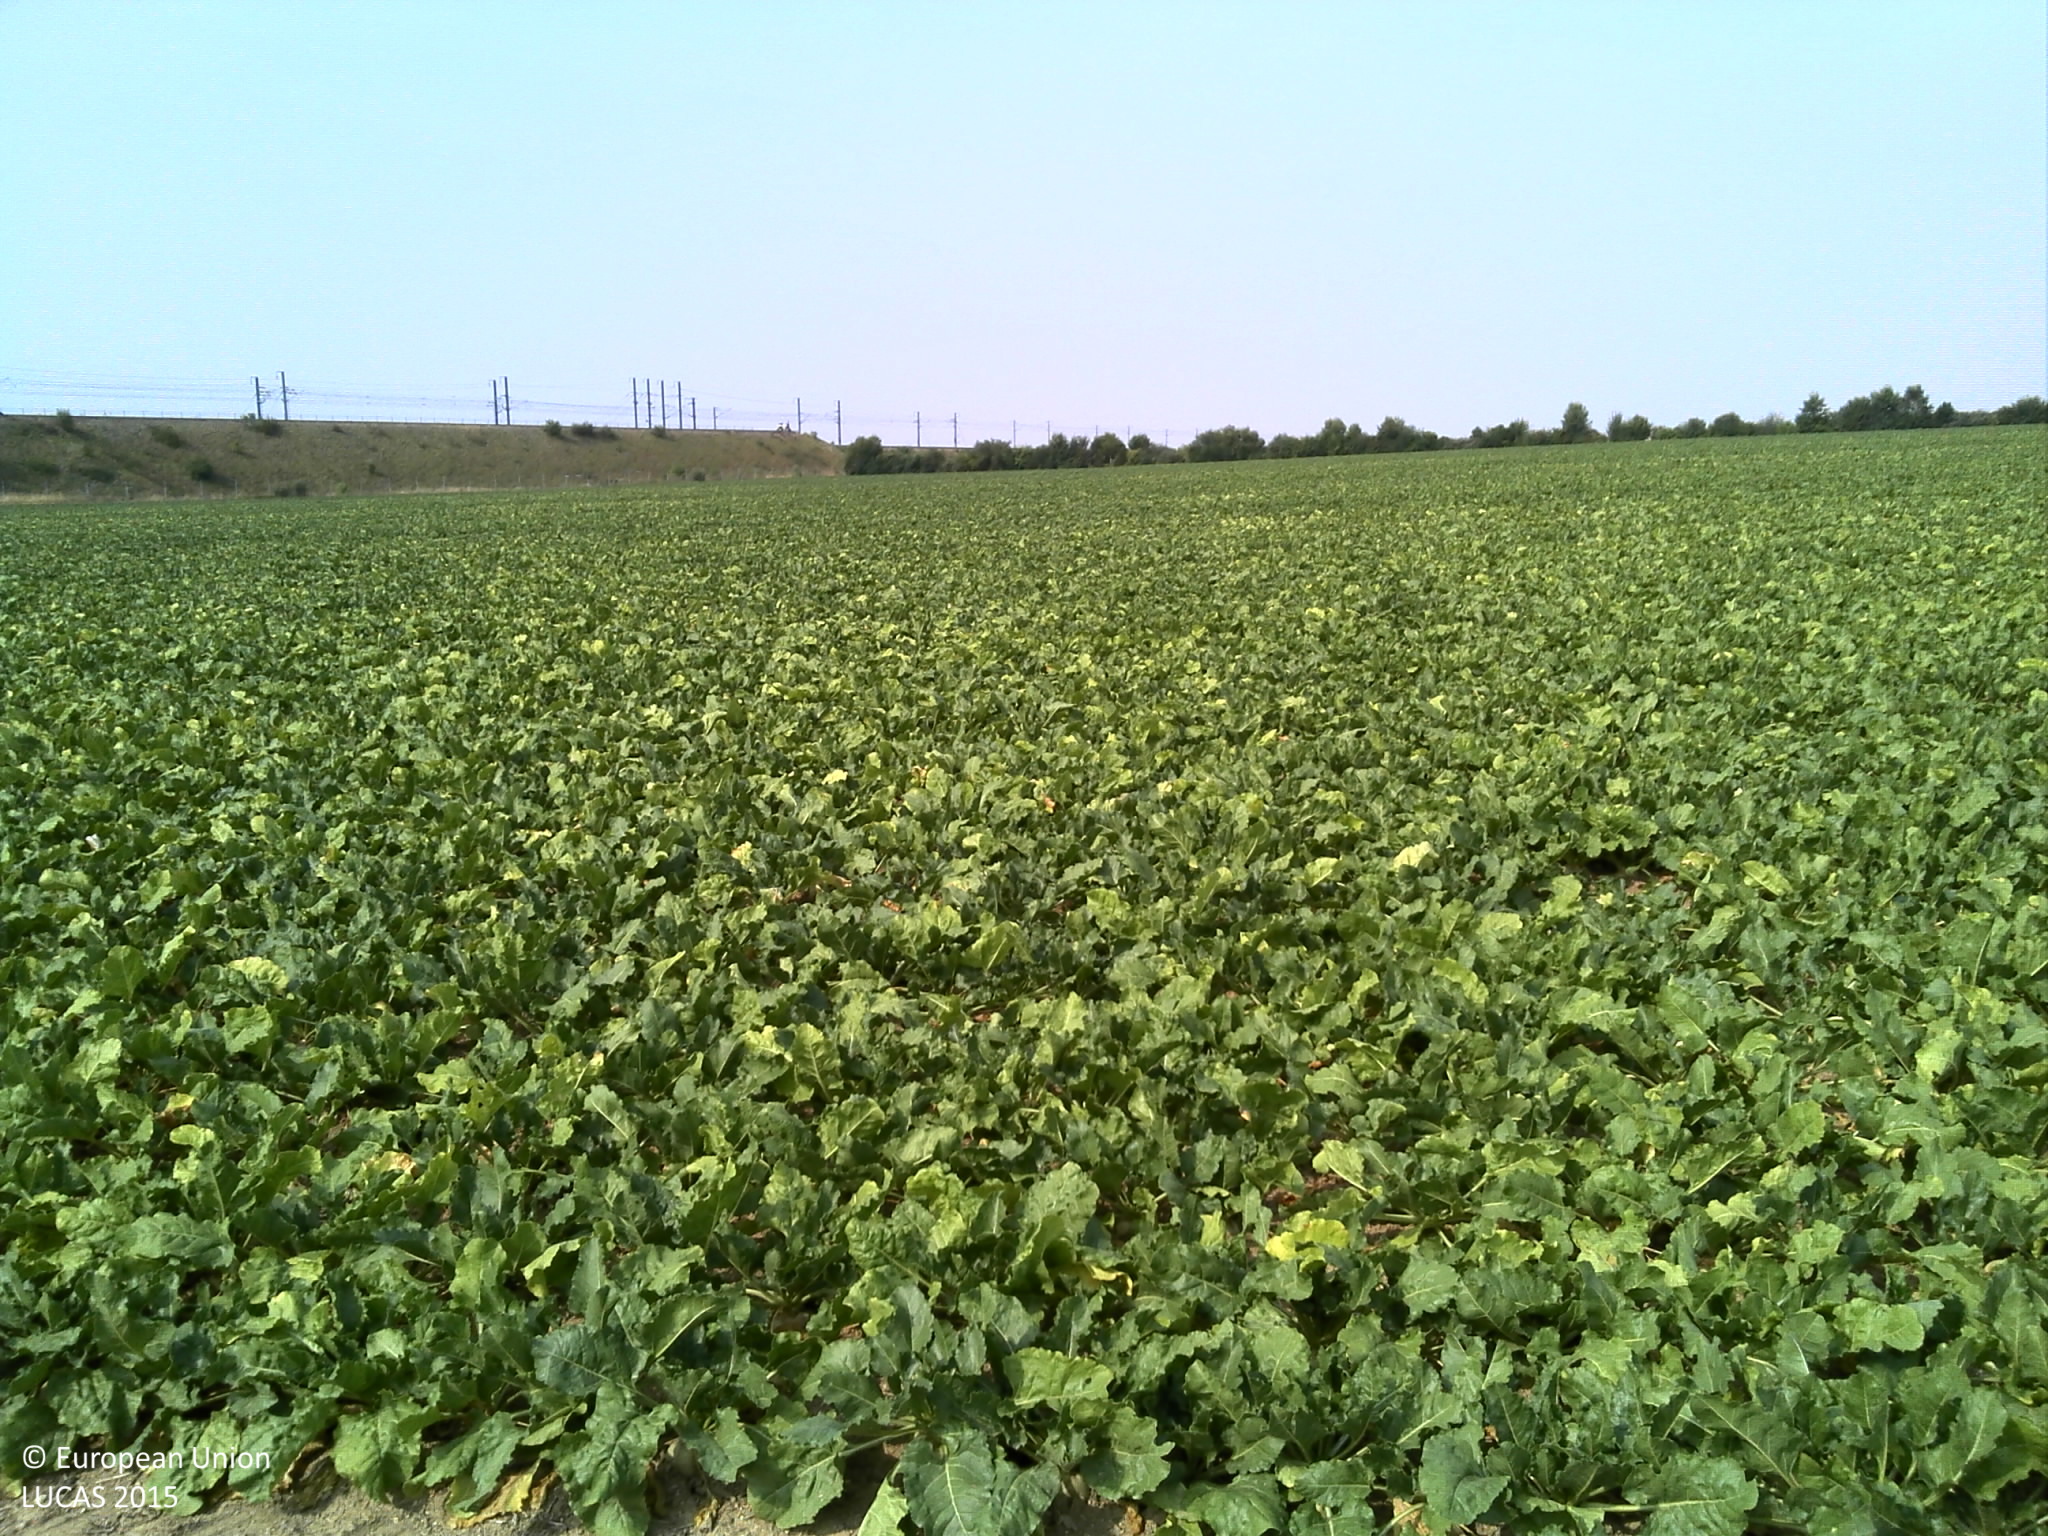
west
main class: Cropland
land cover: Sugar beet
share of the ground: 50 - 75 %
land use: Agriculture (excluding fallow land and kitchen gardens)
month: August
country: FR
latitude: 49.0299
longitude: 4.6219
